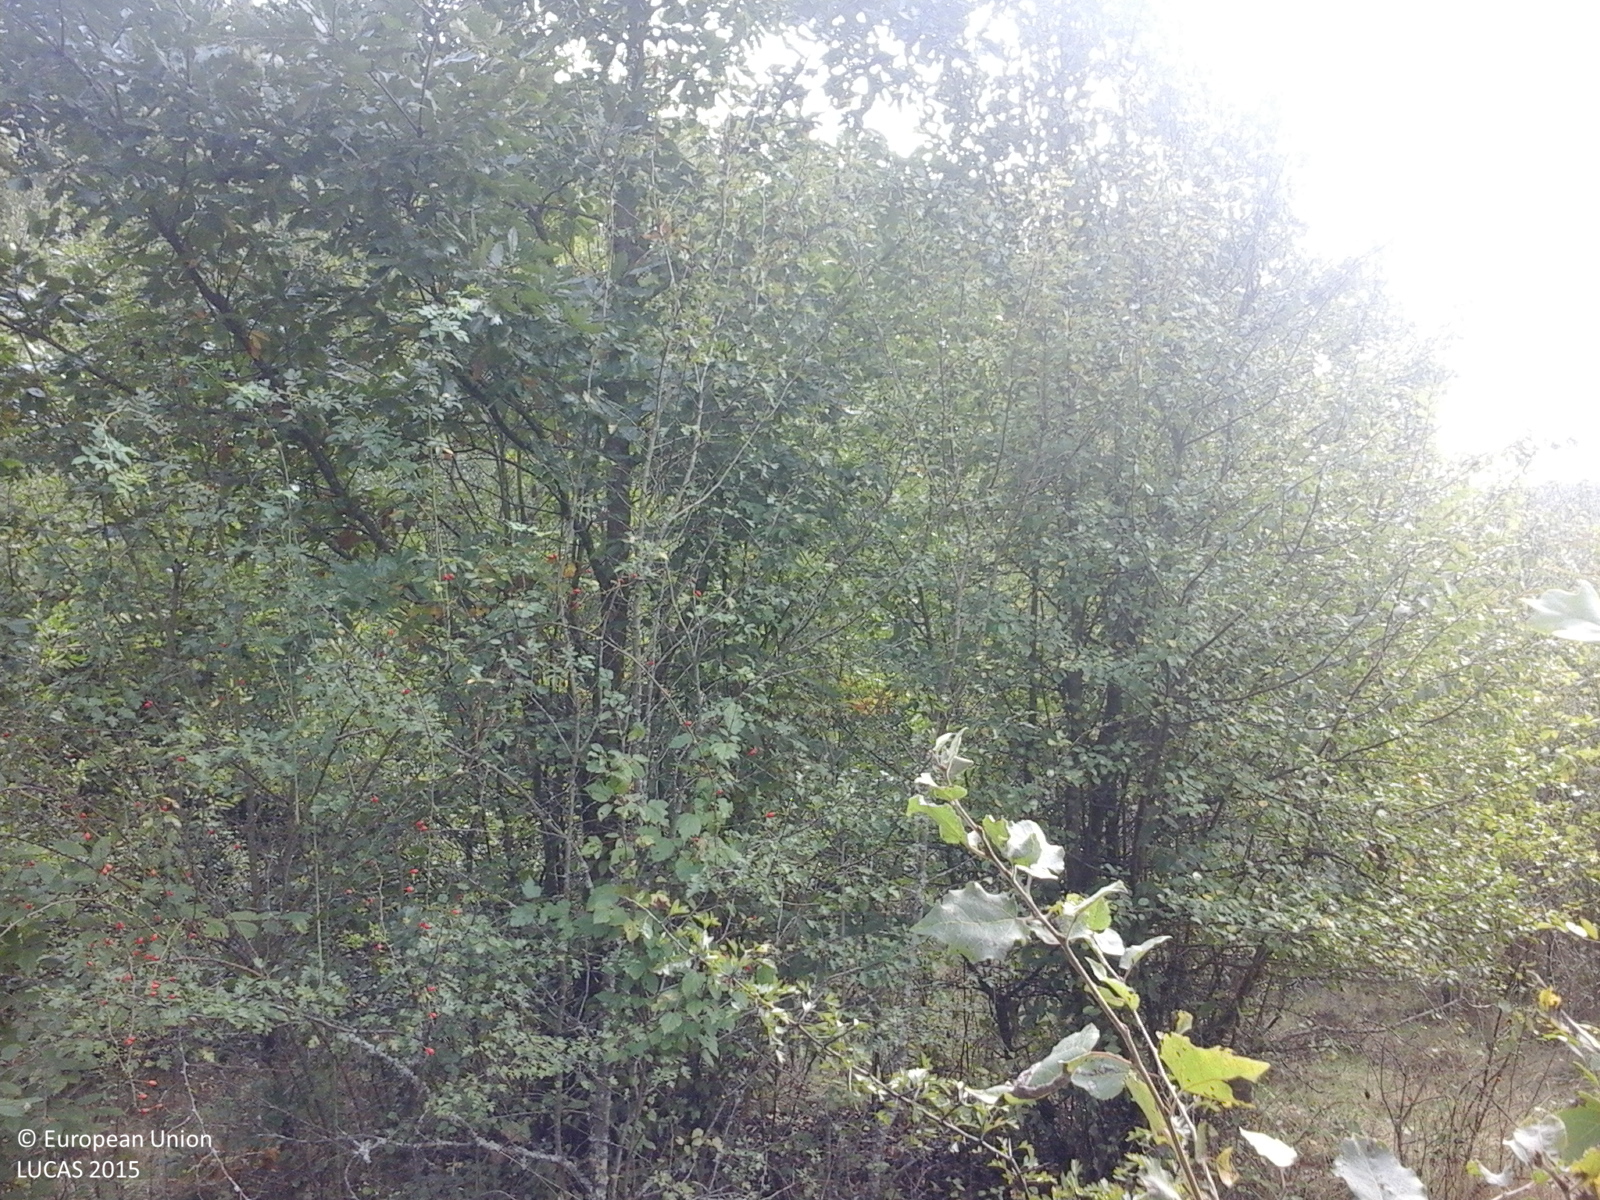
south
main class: Grassland
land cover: Grassland with sparse tree/shrub cover
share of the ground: > 75 %
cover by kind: herbaceous plants 85 %, shrubs 10 %, broadleaved forest trees 5 %
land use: Semi-natural and natural areas not in use
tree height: > 5 m
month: September
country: RO
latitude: 45.9462
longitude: 22.1564
